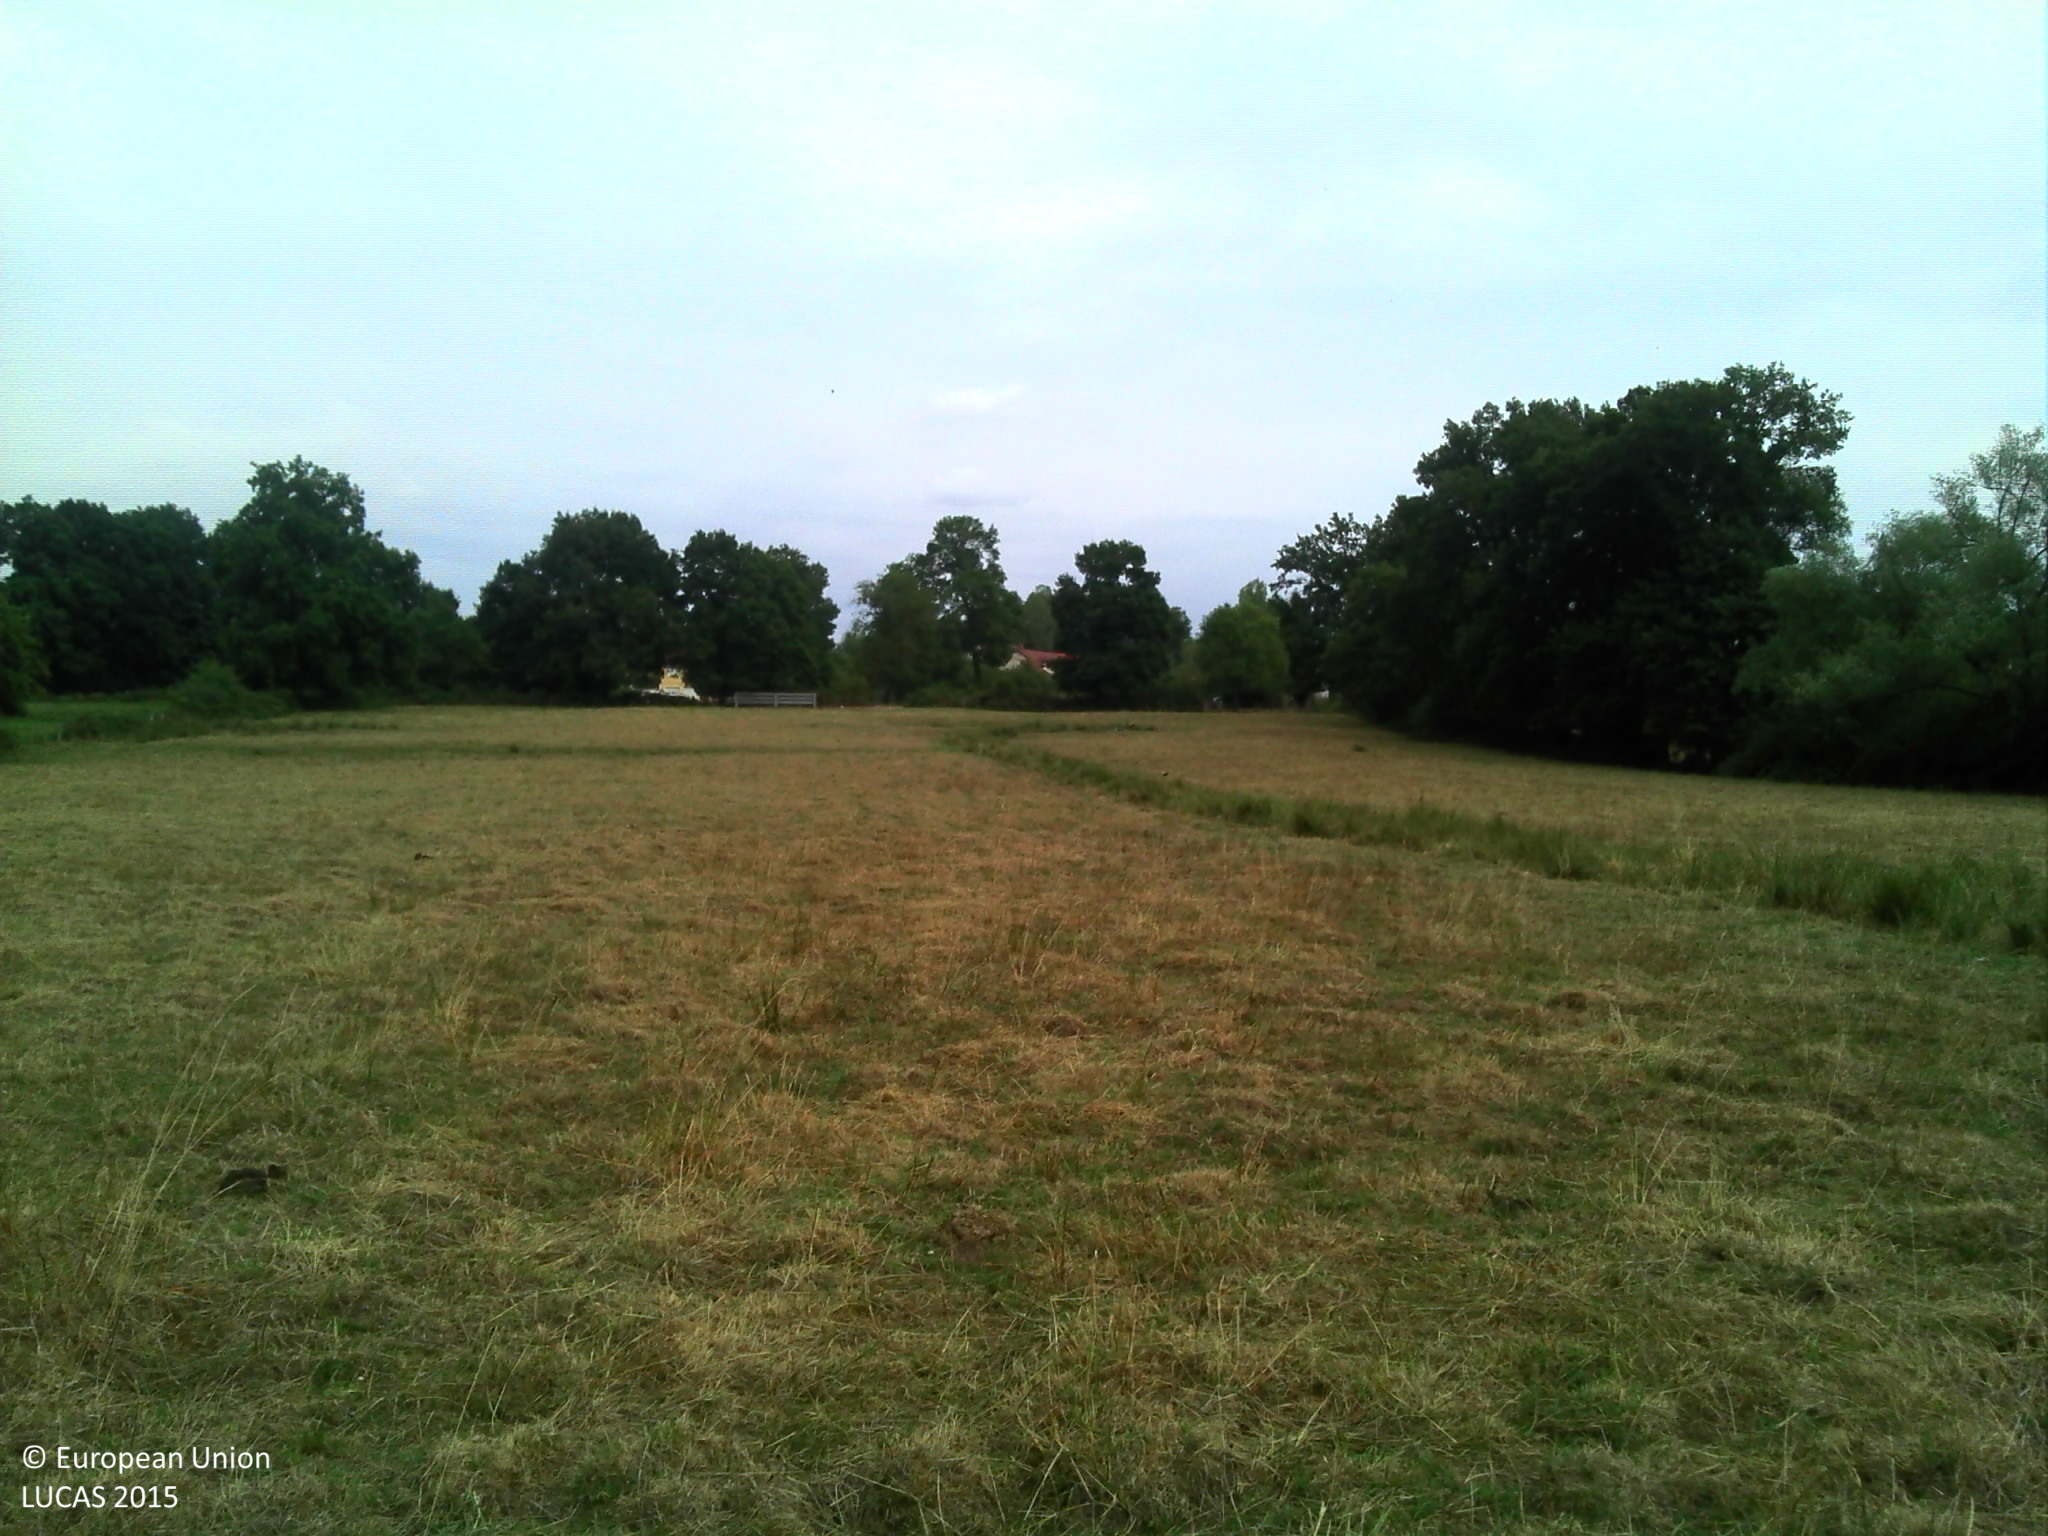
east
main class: Grassland
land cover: Grassland without tree/shrub cover
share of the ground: > 75 %
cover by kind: herbaceous plants 100 %
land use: Agriculture (excluding fallow land and kitchen gardens)
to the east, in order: Grassland without tree/shrub cover; Ponds and wetlands; Inland fresh water bodies; Grassland without tree/shrub cover; Fences; Managed hedges; Spontaneously vegetated surfaces
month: August
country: FR
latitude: 46.2696
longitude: 3.6289
